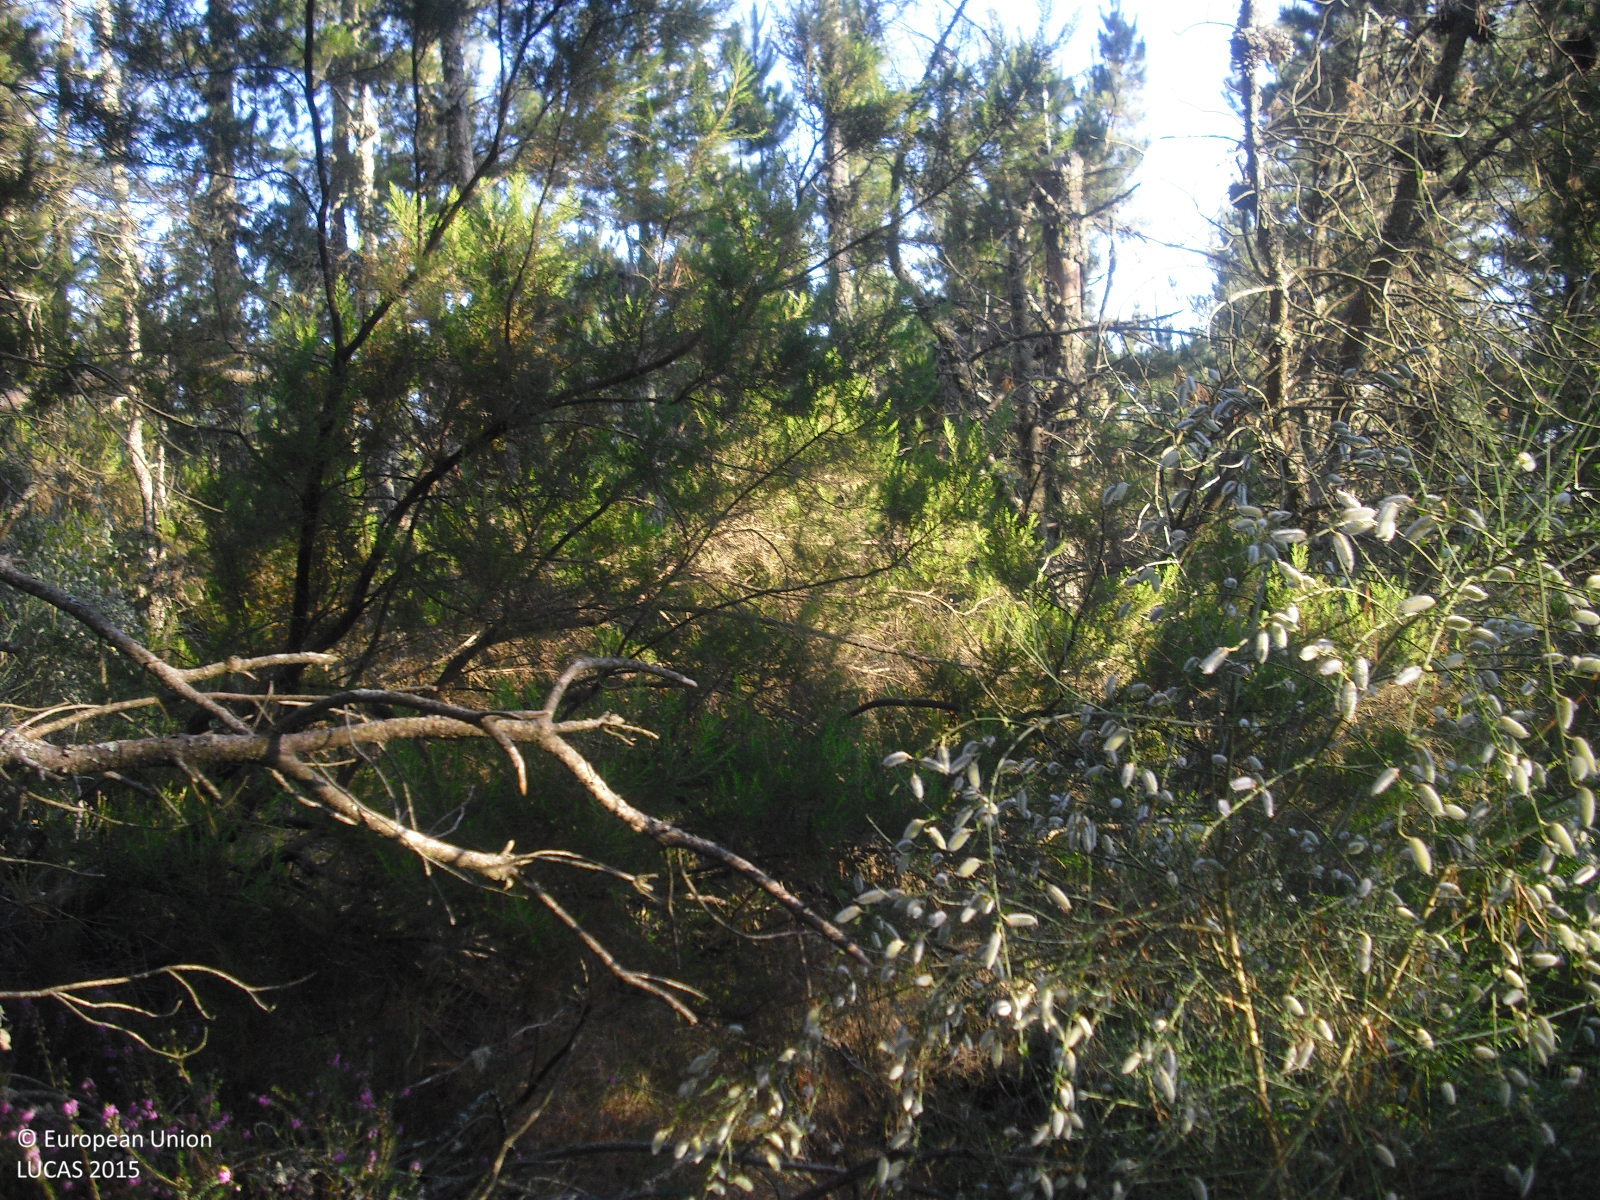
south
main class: Woodland
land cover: Pine dominated coniferous woodland
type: hemiboreal forest and nemoral coniferous forest and mixed broadleaved-coniferous forest
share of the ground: 25 - 50 %
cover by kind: coniferous forest trees 50 %, shrubs 45 %, broadleaved forest trees 5 %
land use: Forestry
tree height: > 5 m
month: July
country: ES
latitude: 42.5920
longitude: -7.2839
